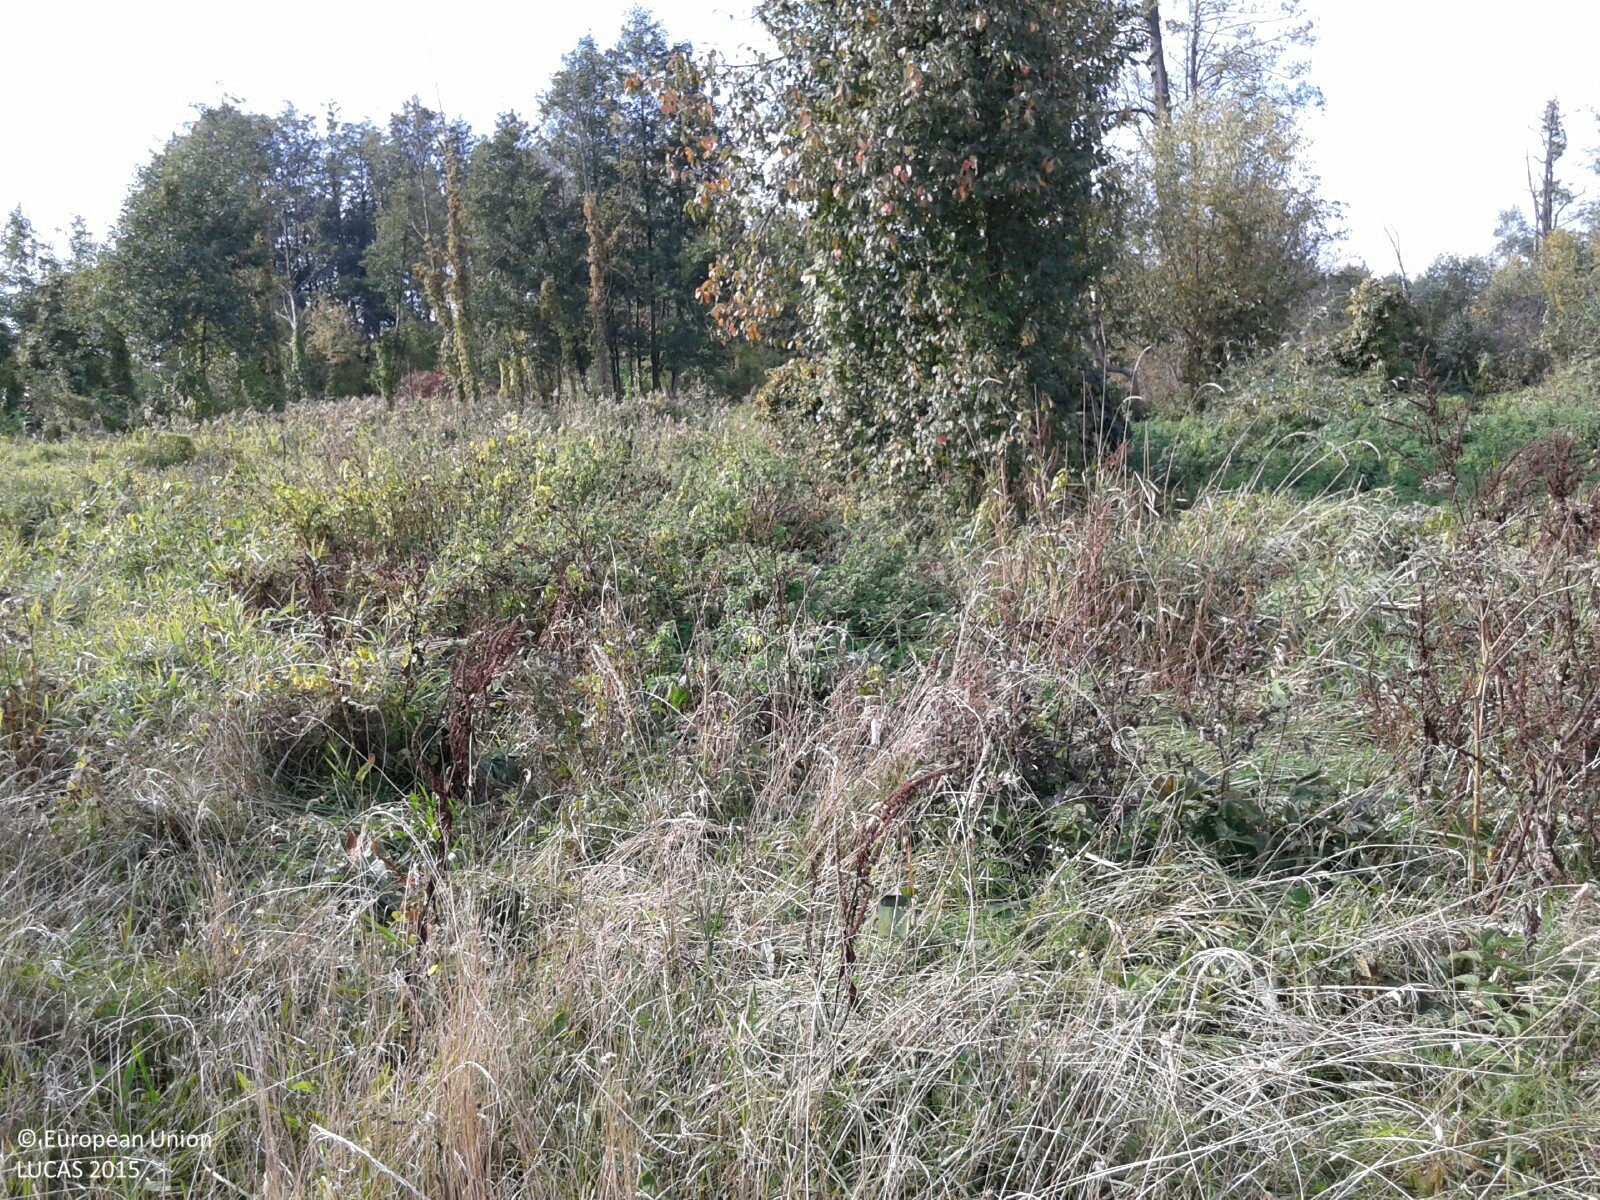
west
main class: Grassland
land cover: Spontaneously vegetated surfaces
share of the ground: > 75 %
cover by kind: herbaceous plants 95 %, shrubs 5 %
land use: Fallow land
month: September
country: PL
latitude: 52.5874
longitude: 22.1491
